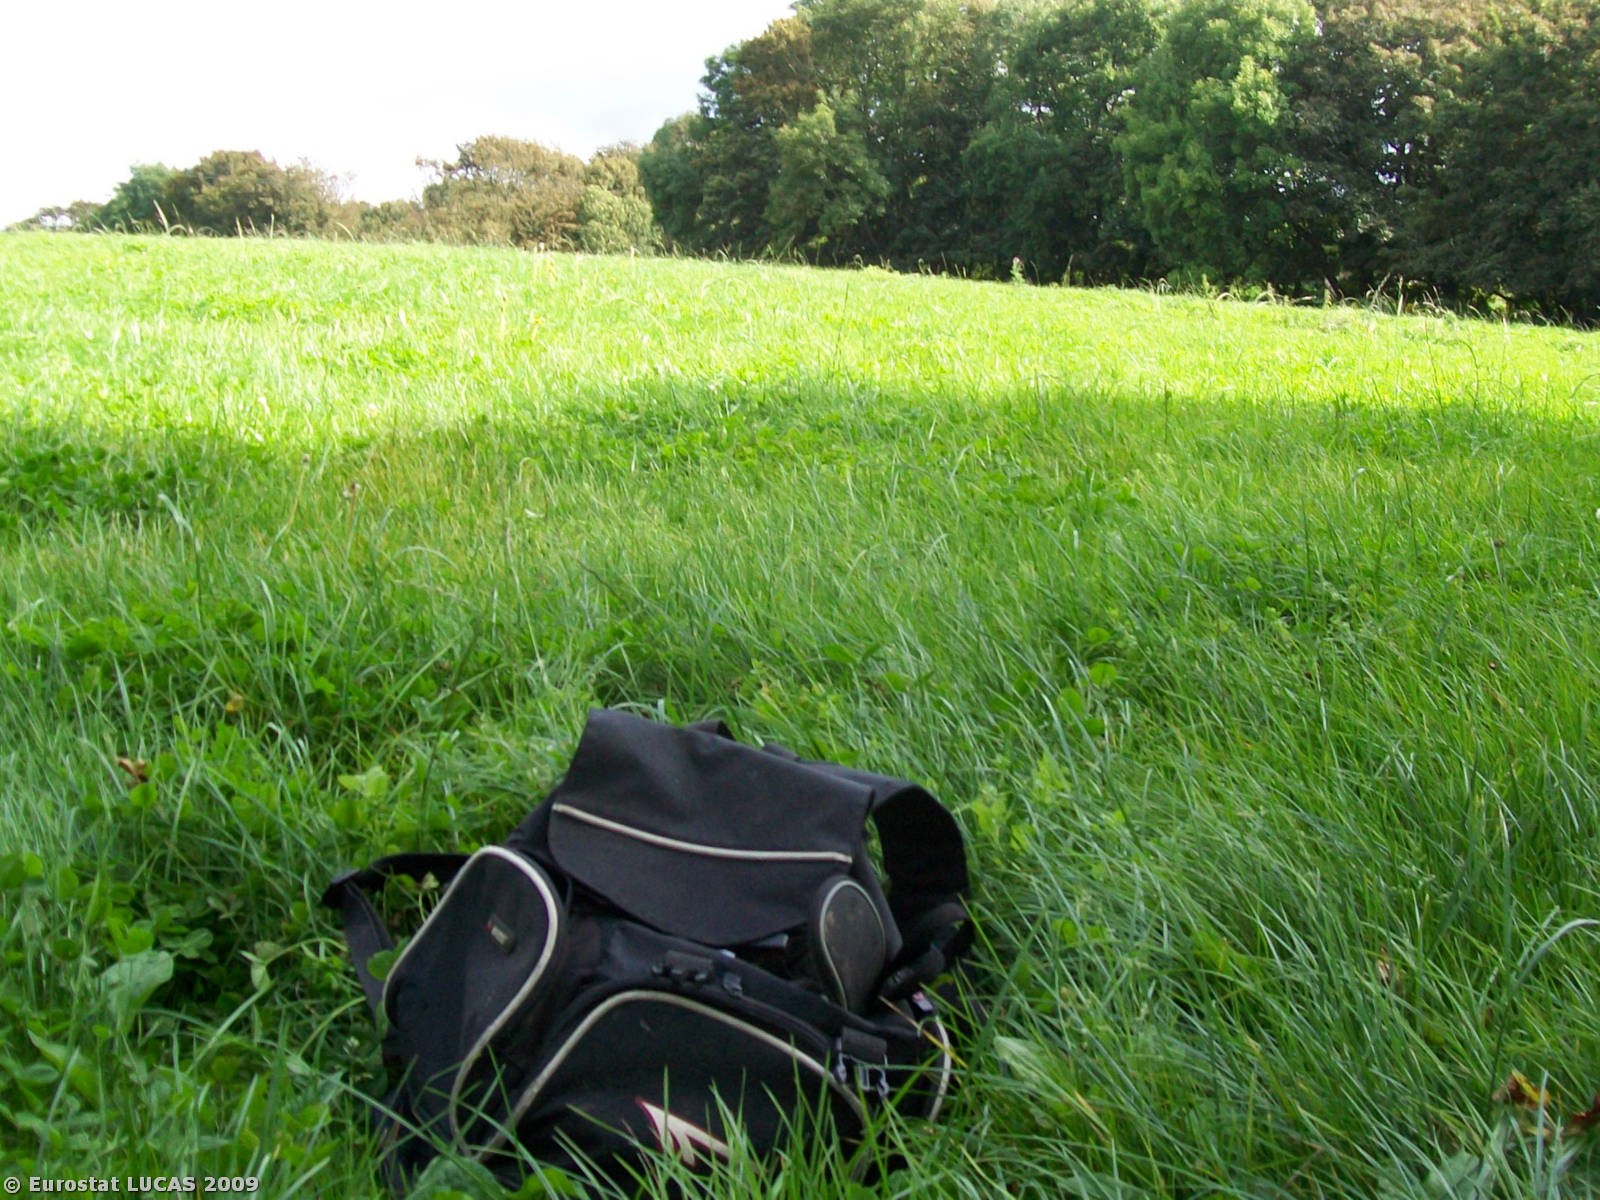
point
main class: Grassland
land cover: Grassland without tree/shrub cover
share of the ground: > 75 %
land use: Agriculture (excluding fallow land and kitchen gardens)
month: September
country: GB
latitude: 52.0257
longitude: -4.8182
